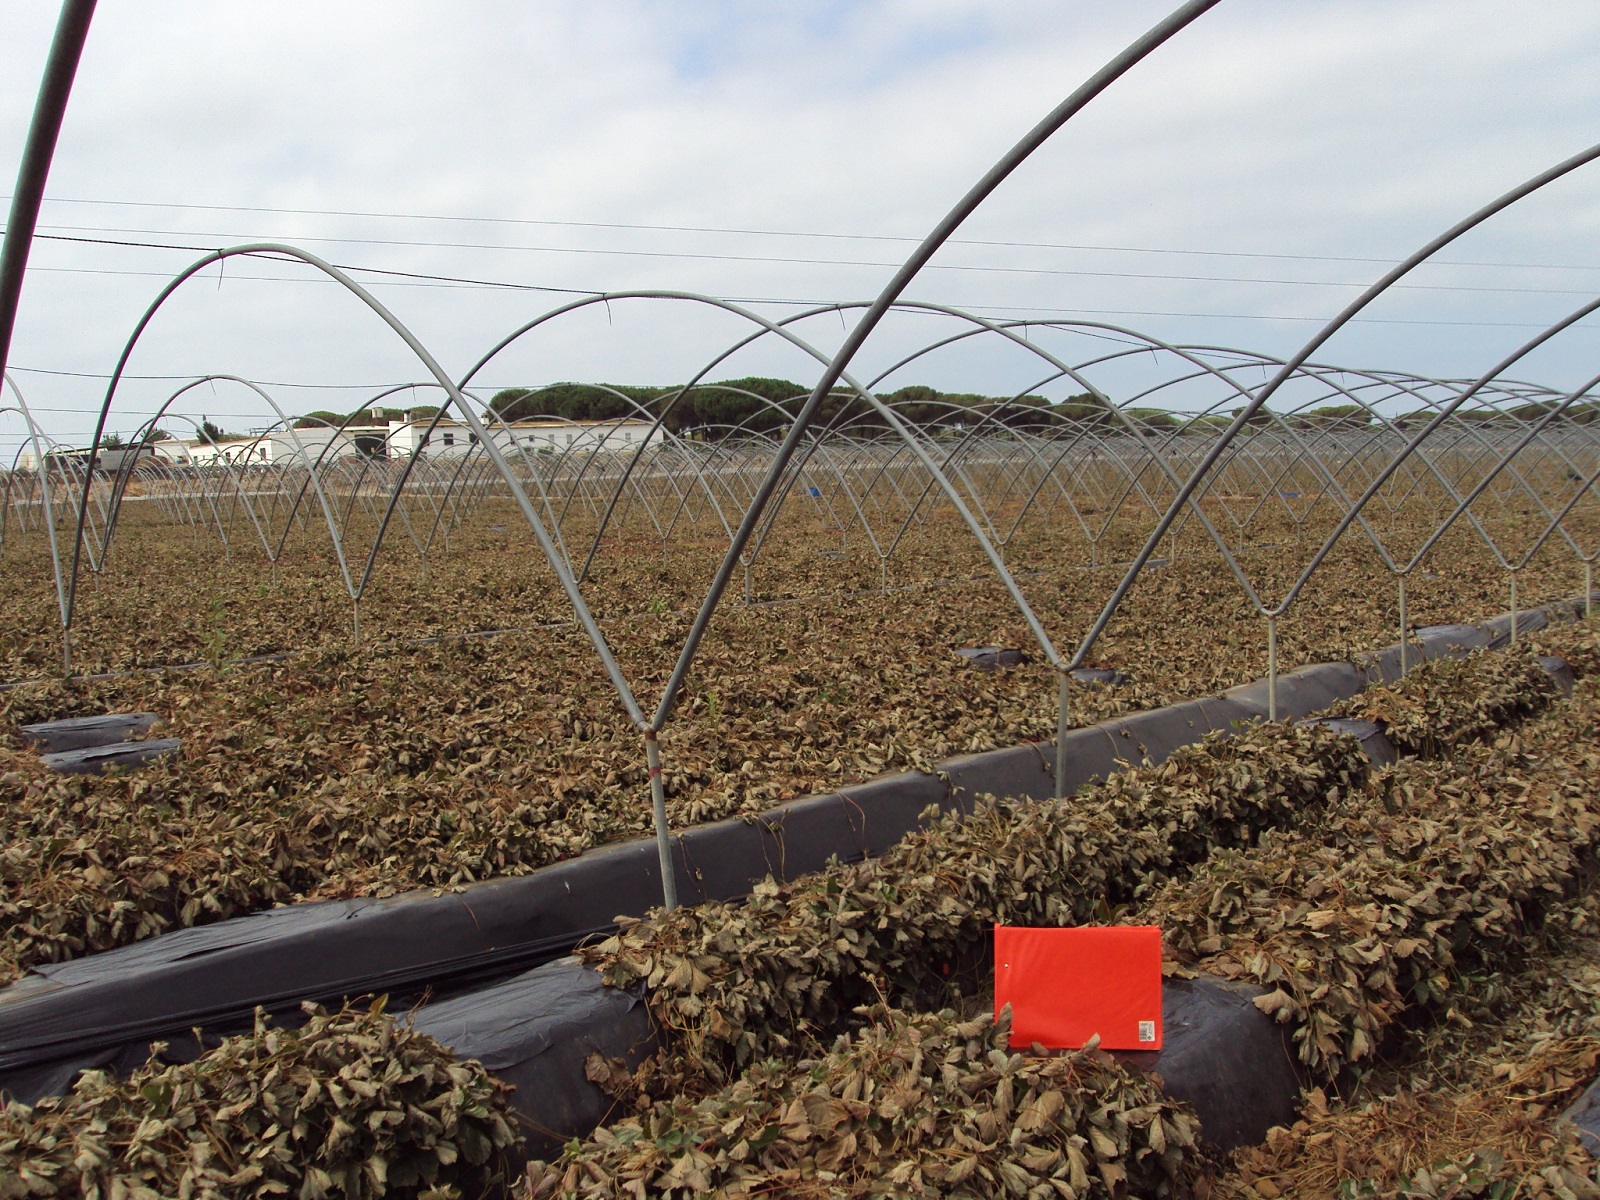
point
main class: Artificial land
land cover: Greenhouses
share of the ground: > 75 %
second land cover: Strawberries
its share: > 75 %
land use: Agriculture (excluding fallow land and kitchen gardens)
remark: Harvested field
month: June
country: ES
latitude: 37.1743
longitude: -6.8499
